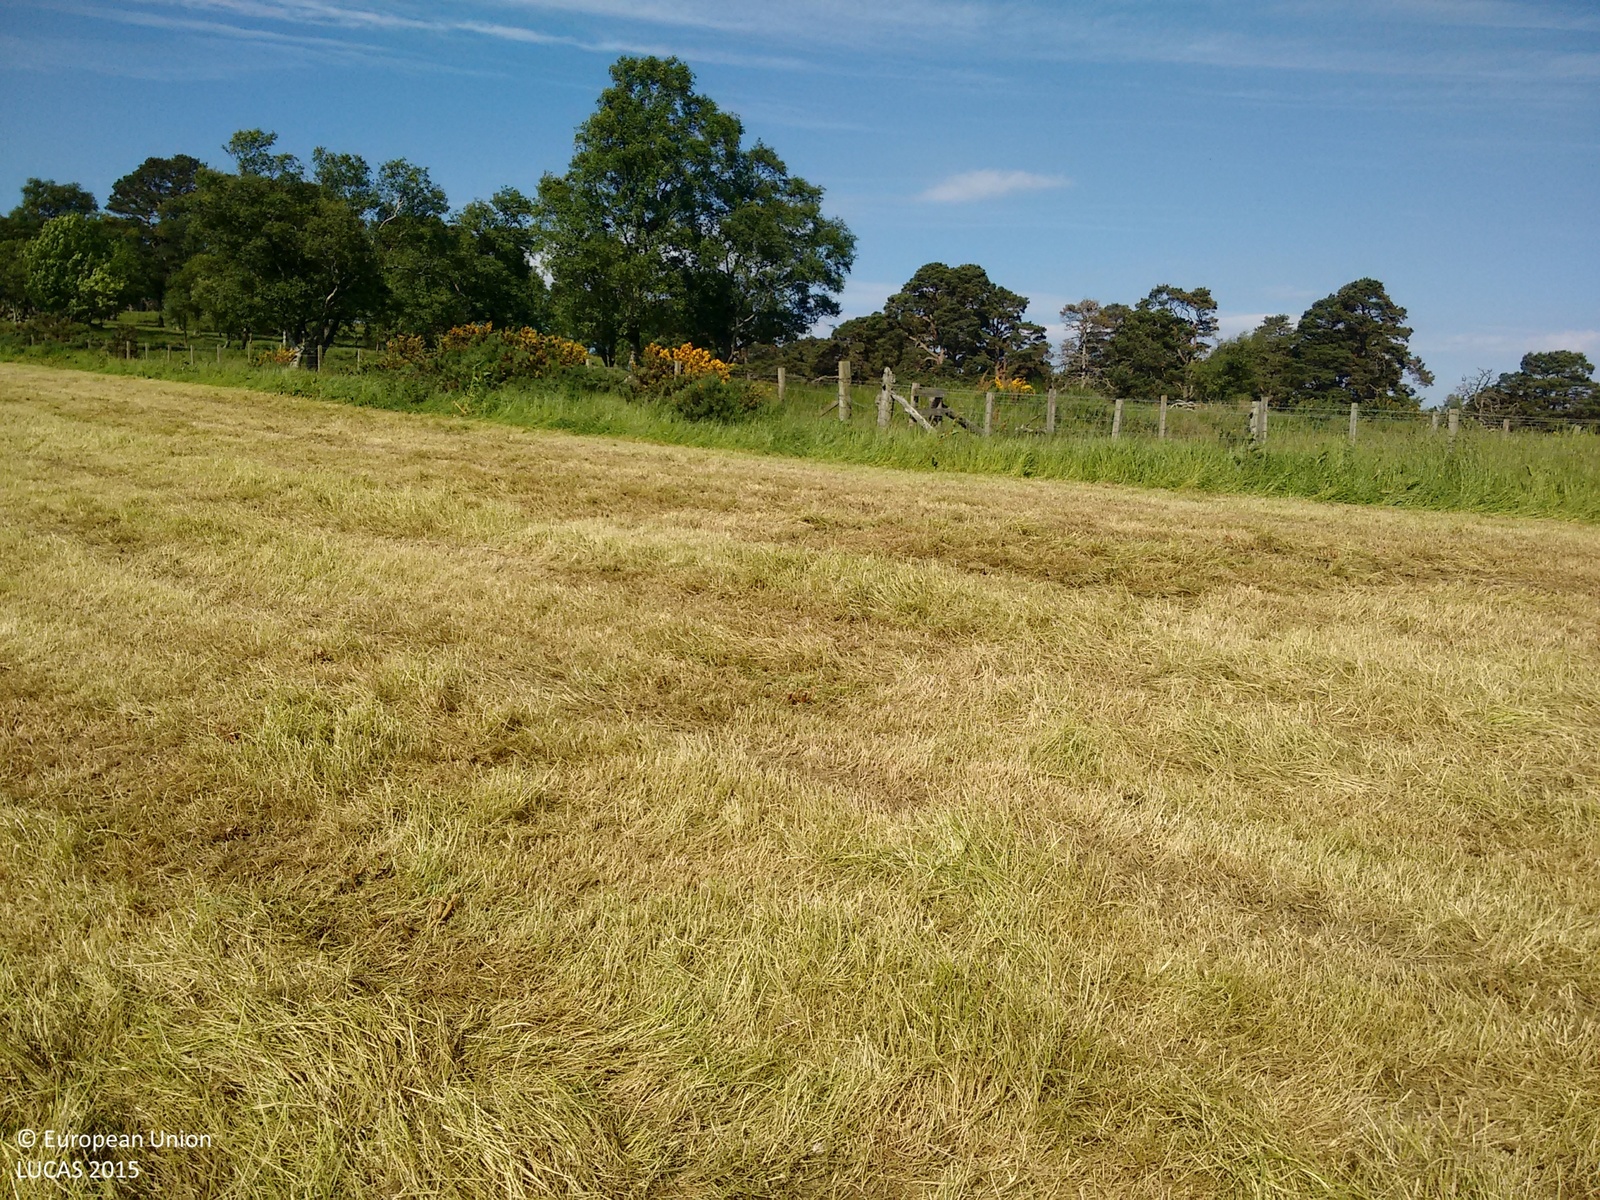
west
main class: Cropland
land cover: Temporary grasslands
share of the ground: > 75 %
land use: Agriculture (excluding fallow land and kitchen gardens)
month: July
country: GB
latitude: 57.4941
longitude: -2.9916
